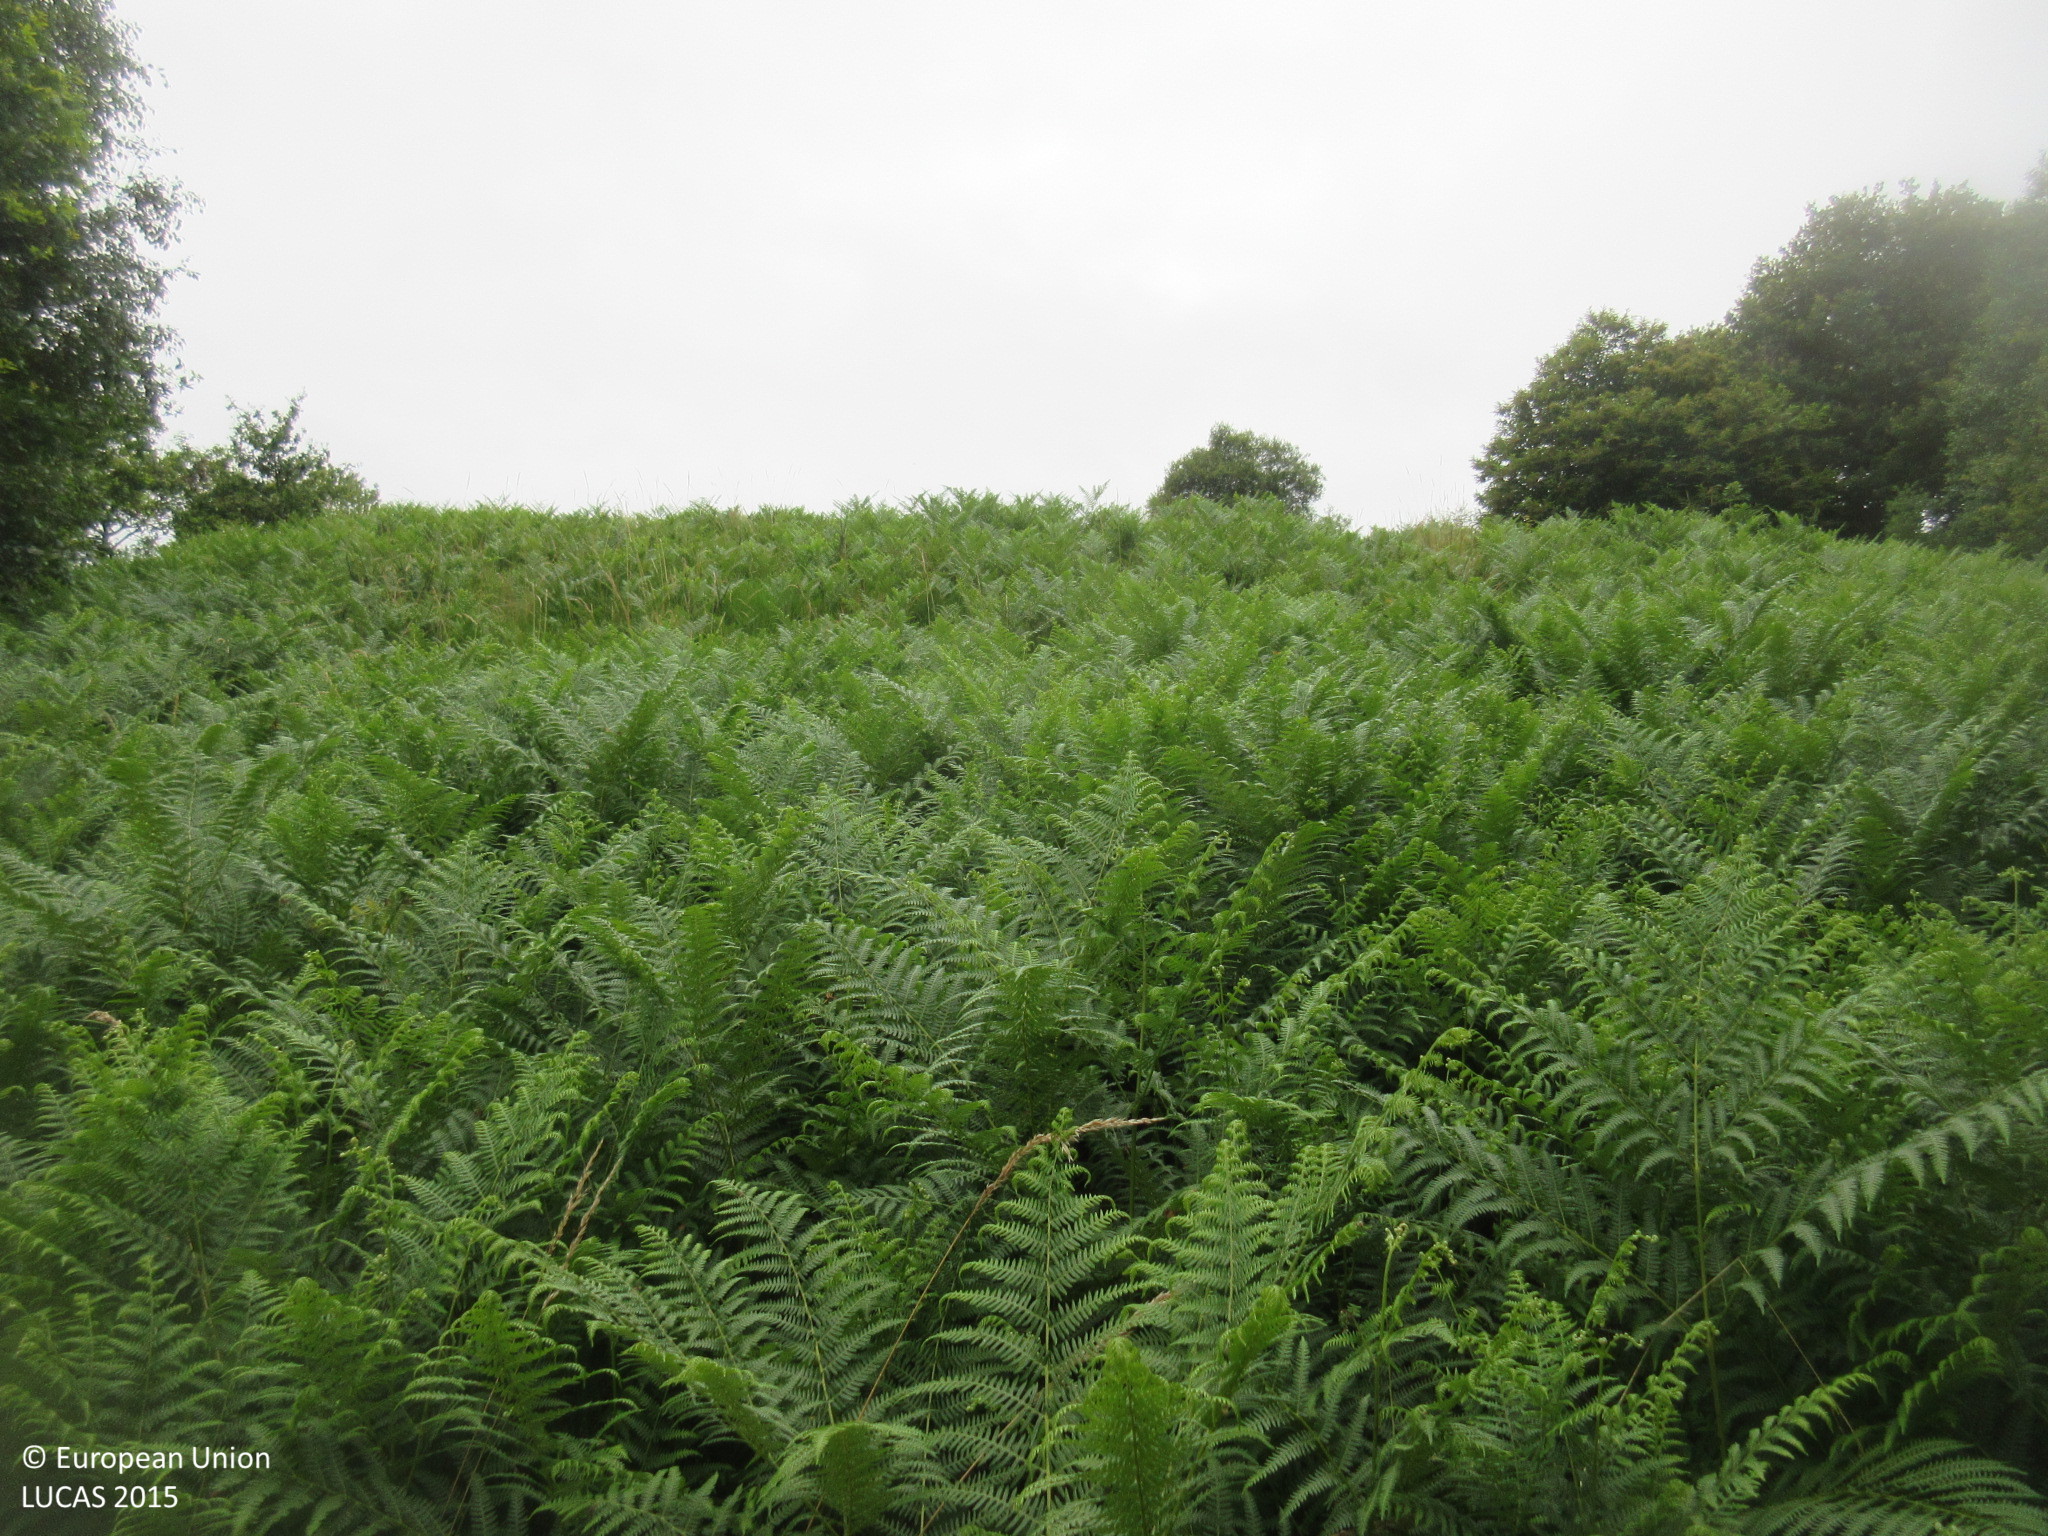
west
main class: Woodland
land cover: Broadleaved woodland
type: acidophilous oak and oak-birch forest
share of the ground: 25 - 50 %
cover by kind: herbaceous plants 60 %, broadleaved forest trees 40 %
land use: Semi-natural and natural areas not in use
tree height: > 5 m
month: July
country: ES
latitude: 43.2263
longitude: -3.4991
